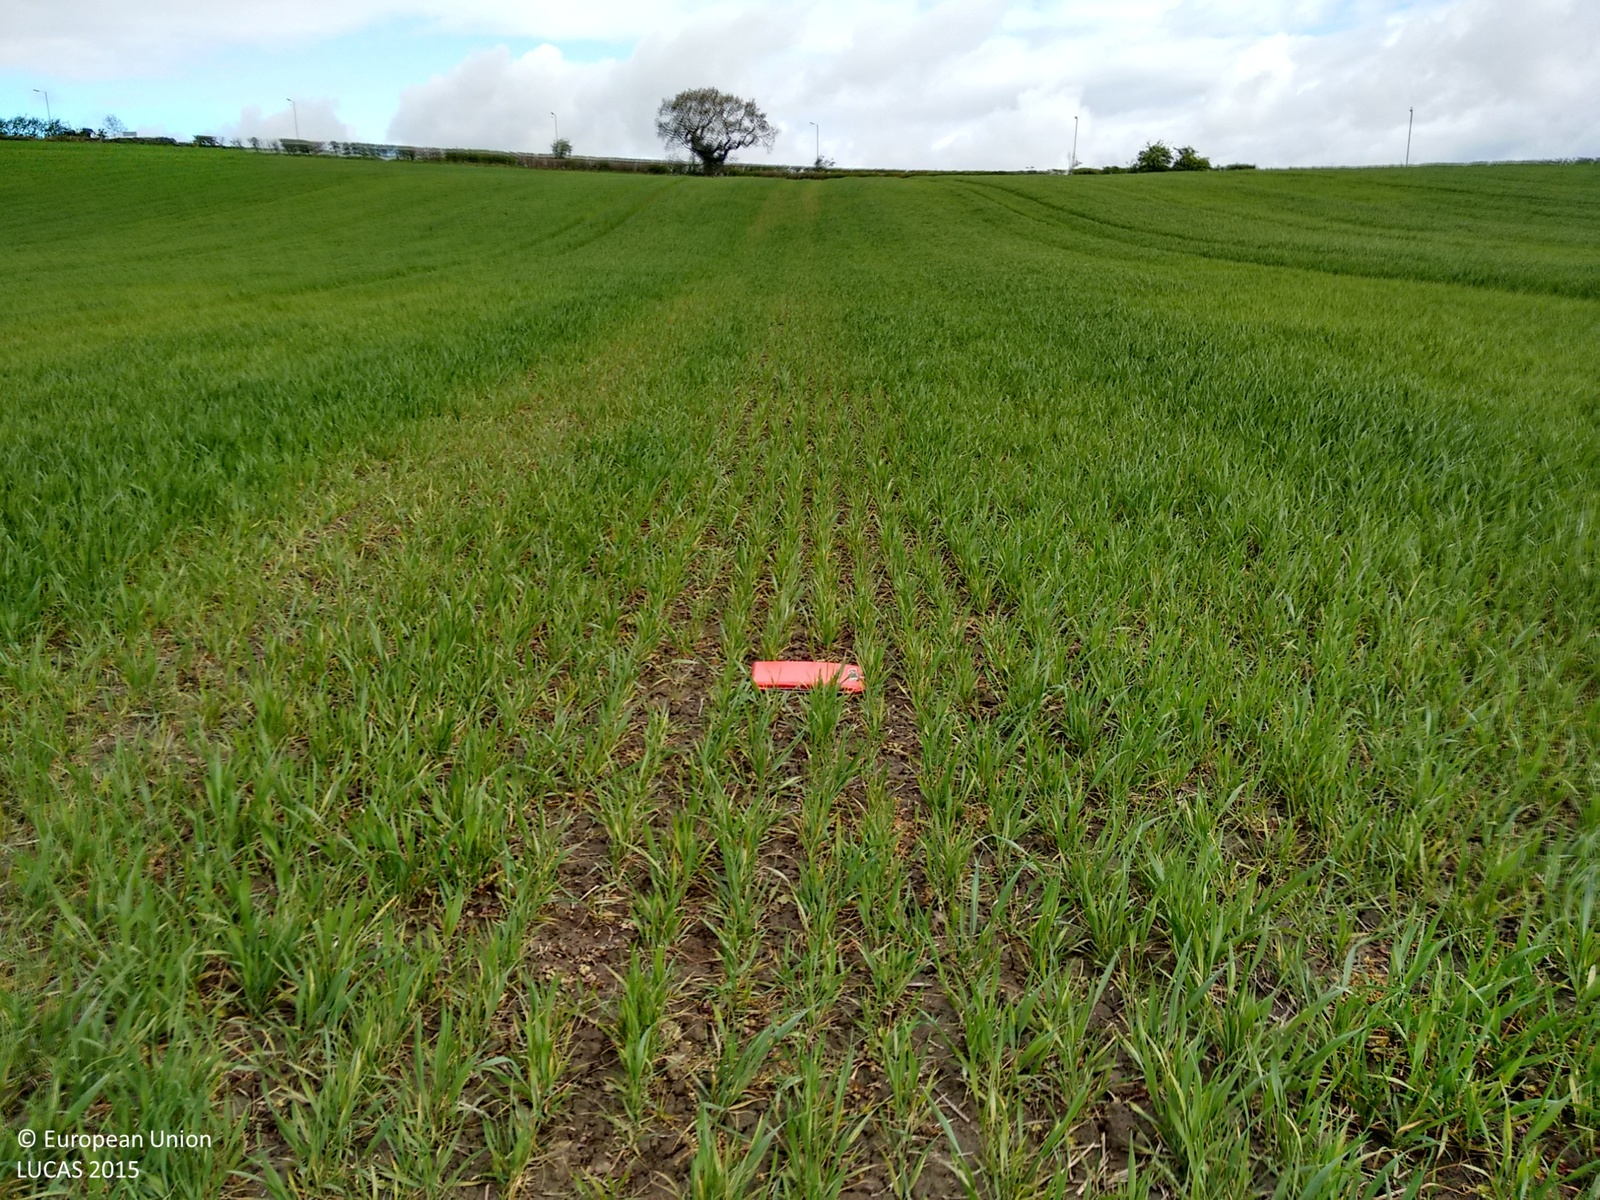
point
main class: Cropland
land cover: Common wheat
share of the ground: > 75 %
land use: Agriculture (excluding fallow land and kitchen gardens)
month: April
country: GB
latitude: 53.6603
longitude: -1.5974
